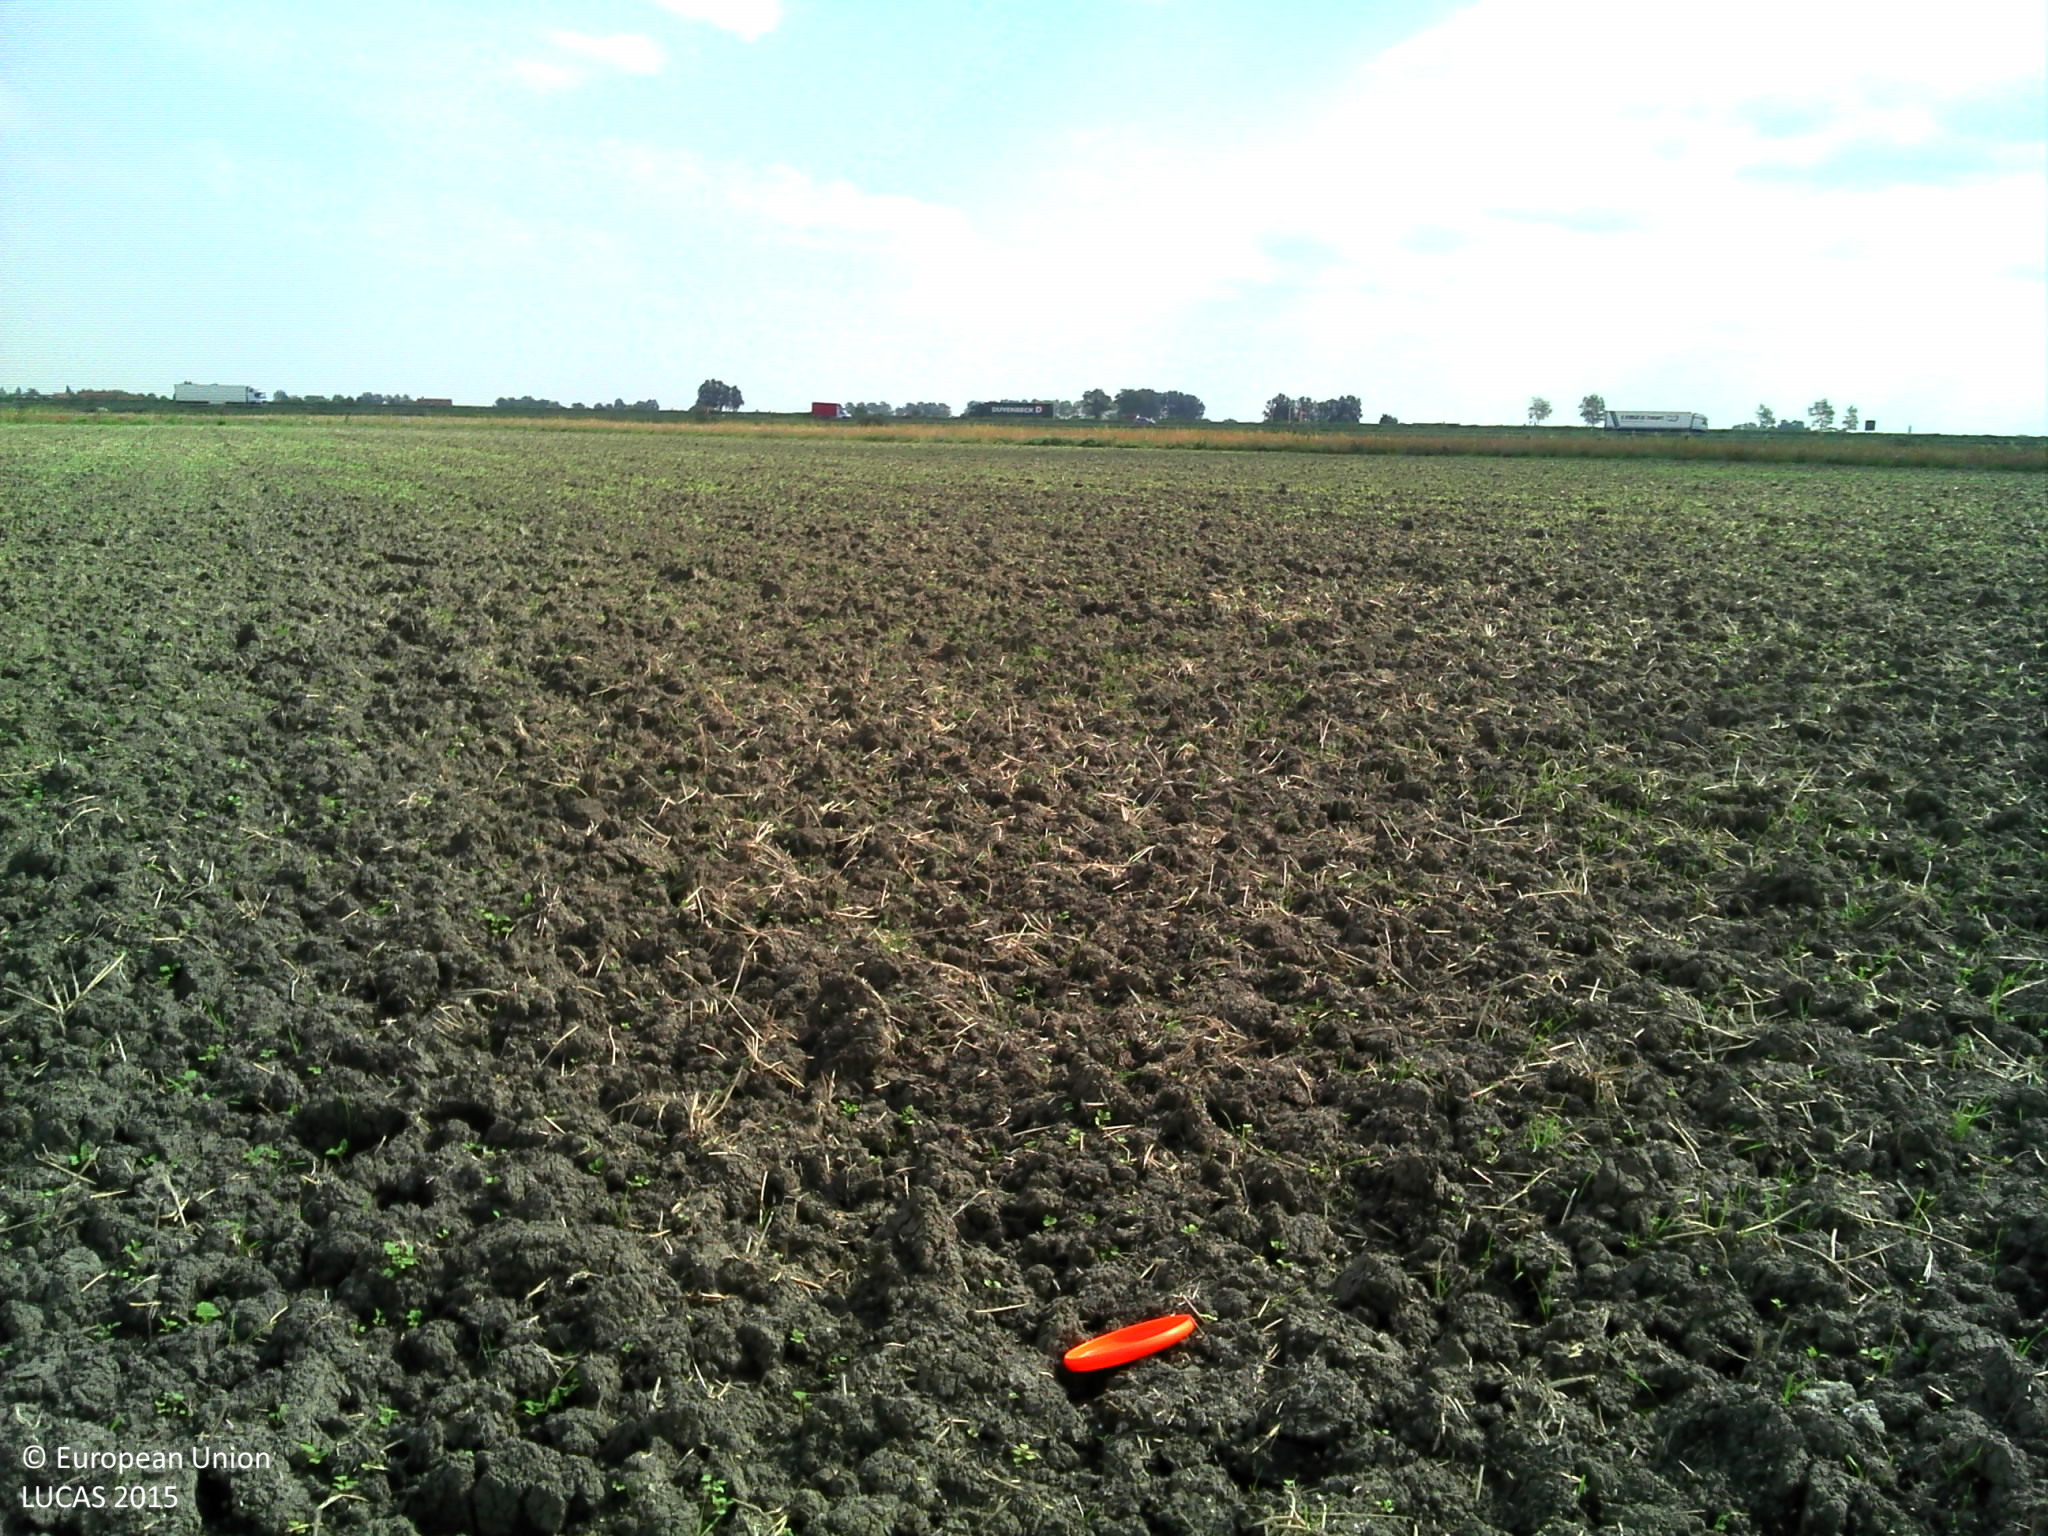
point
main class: Cropland
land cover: Common wheat
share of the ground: < 10 %
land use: Agriculture (excluding fallow land and kitchen gardens)
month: September
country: BE
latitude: 51.0889
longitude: 2.7214
